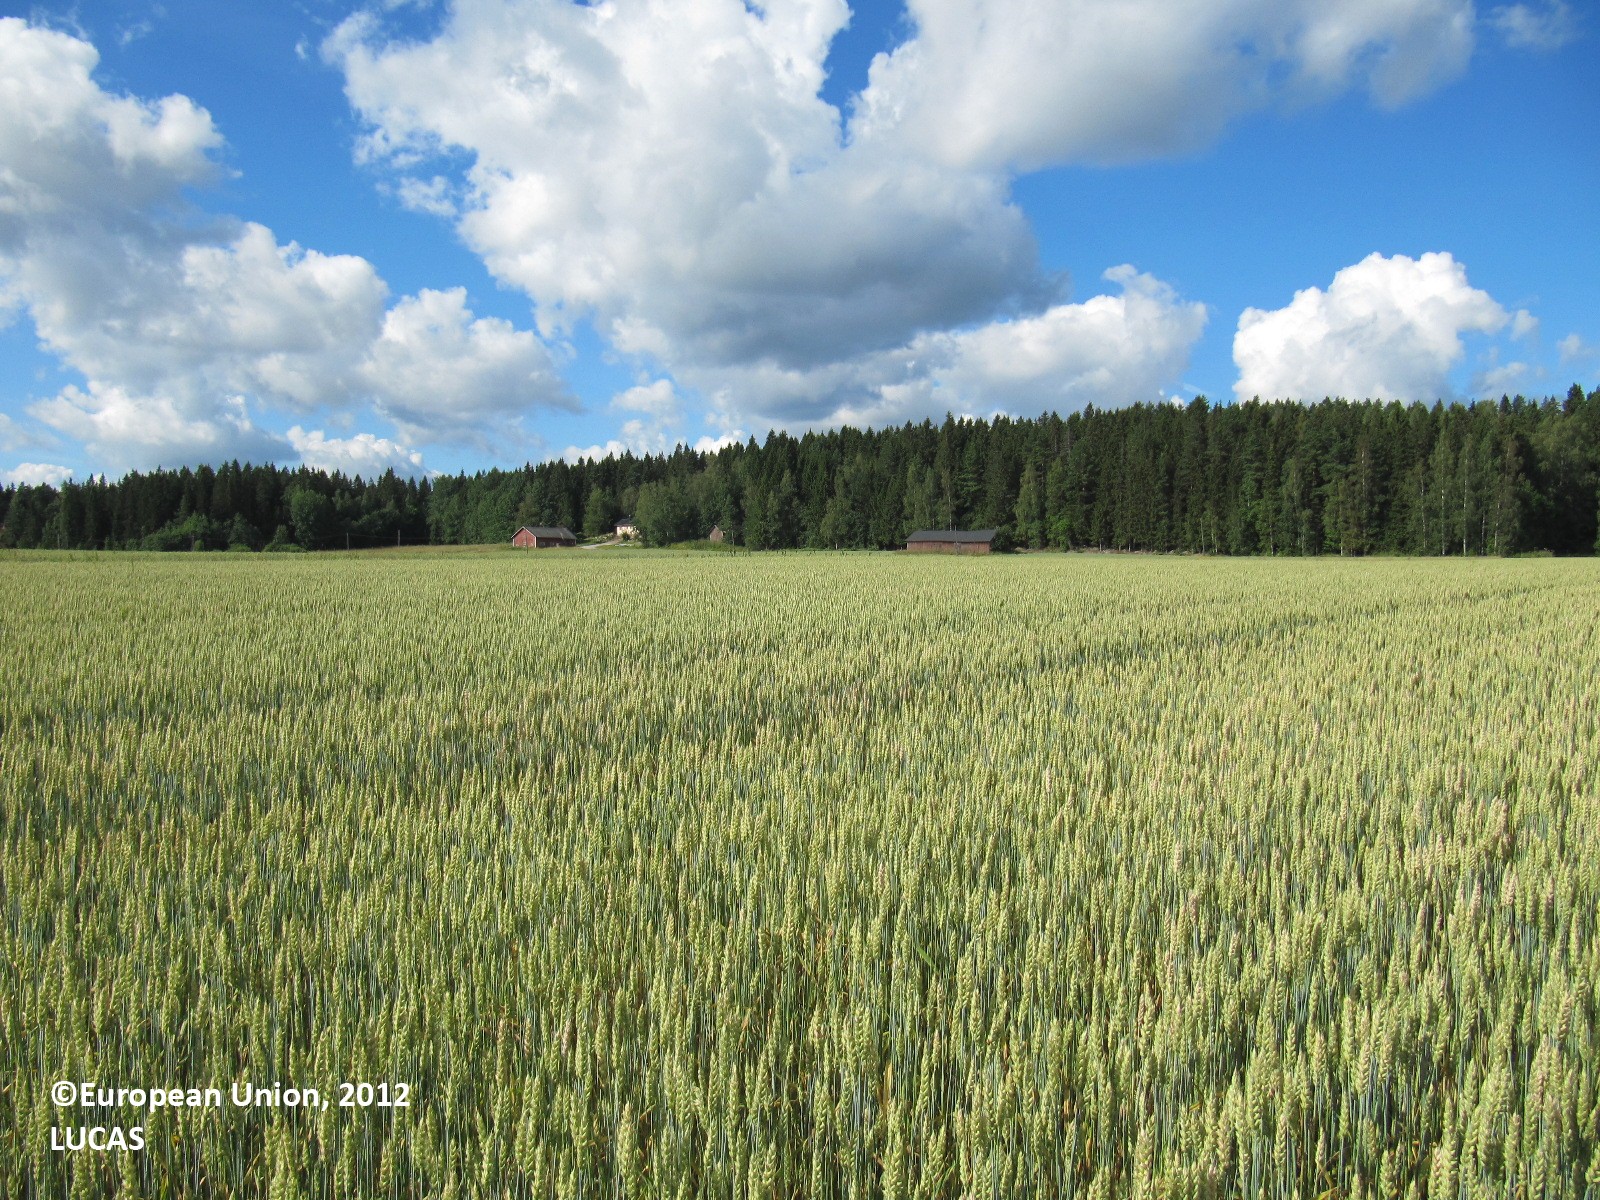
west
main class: Cropland
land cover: Common wheat
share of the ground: > 75 %
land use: Agriculture (excluding fallow land and kitchen gardens)
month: August
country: FI
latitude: 60.5103
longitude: 23.1748
